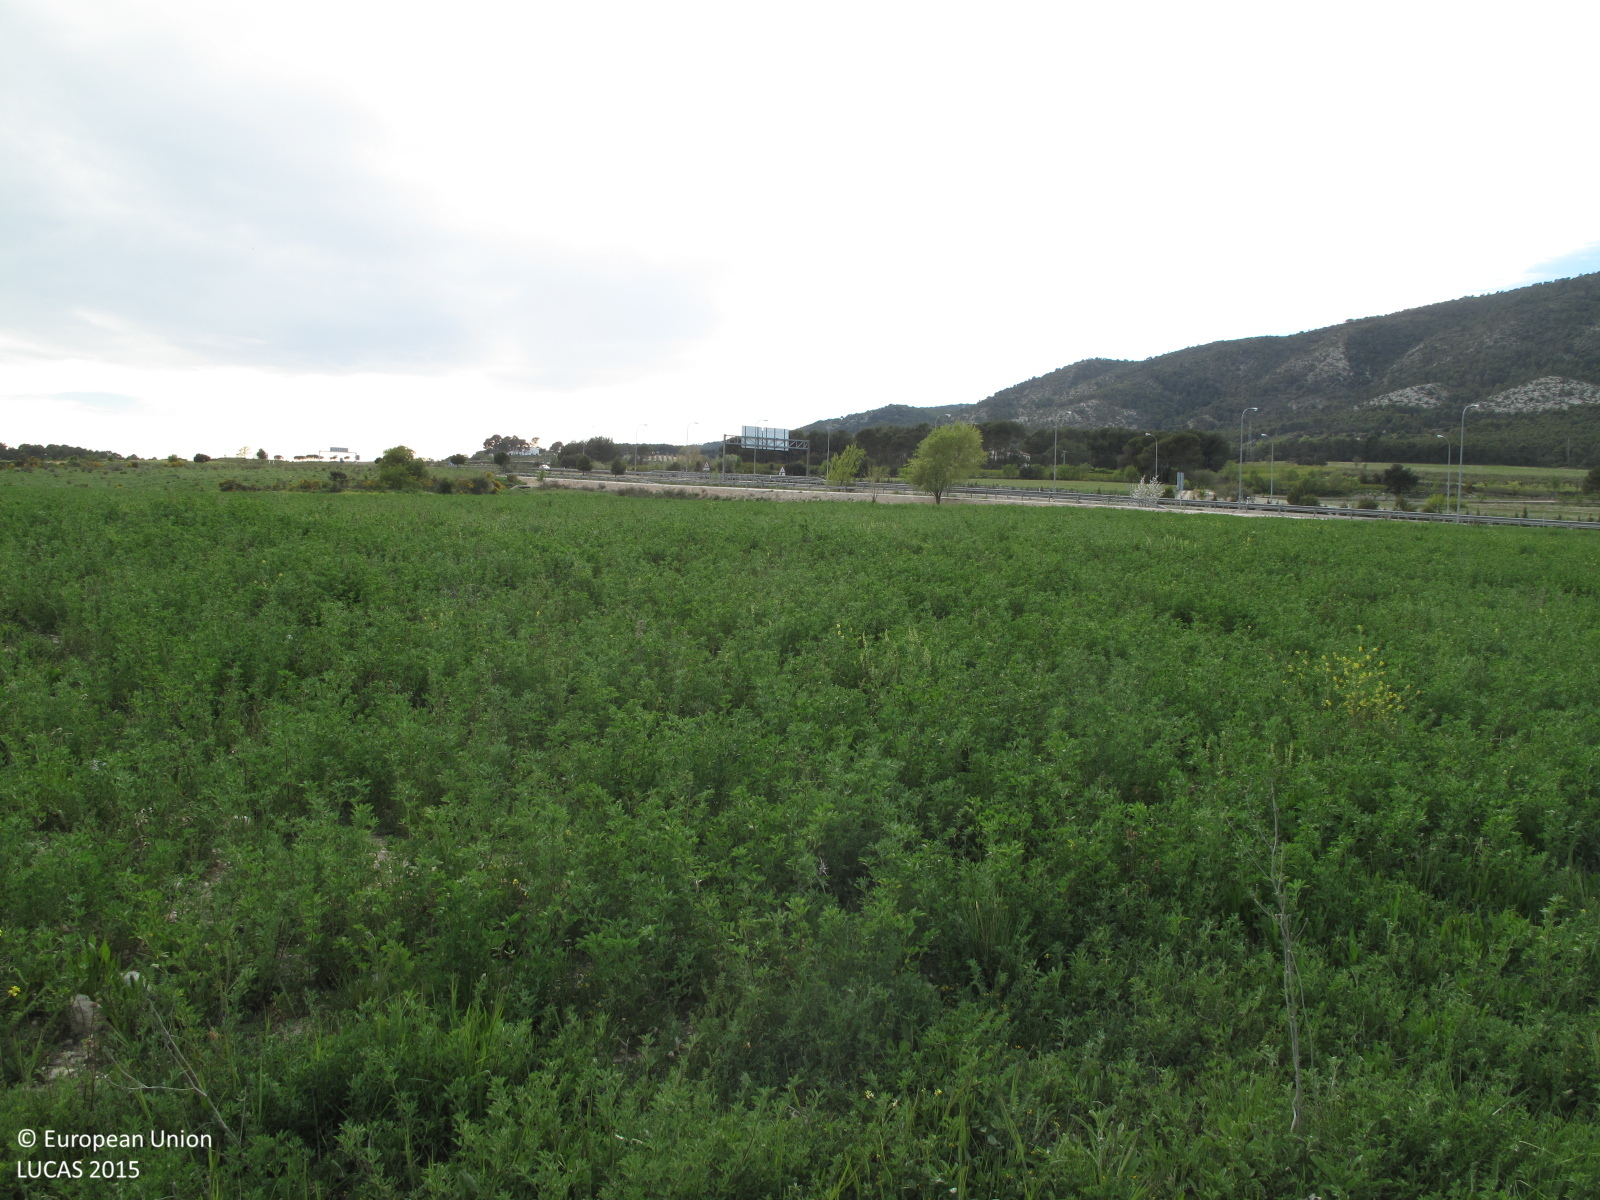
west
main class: Grassland
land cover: Grassland without tree/shrub cover
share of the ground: > 75 %
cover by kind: herbaceous plants 95 %, consolidated bare surface 5 %
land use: Abandoned areas
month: April
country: ES
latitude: 38.6465
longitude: -0.4789
